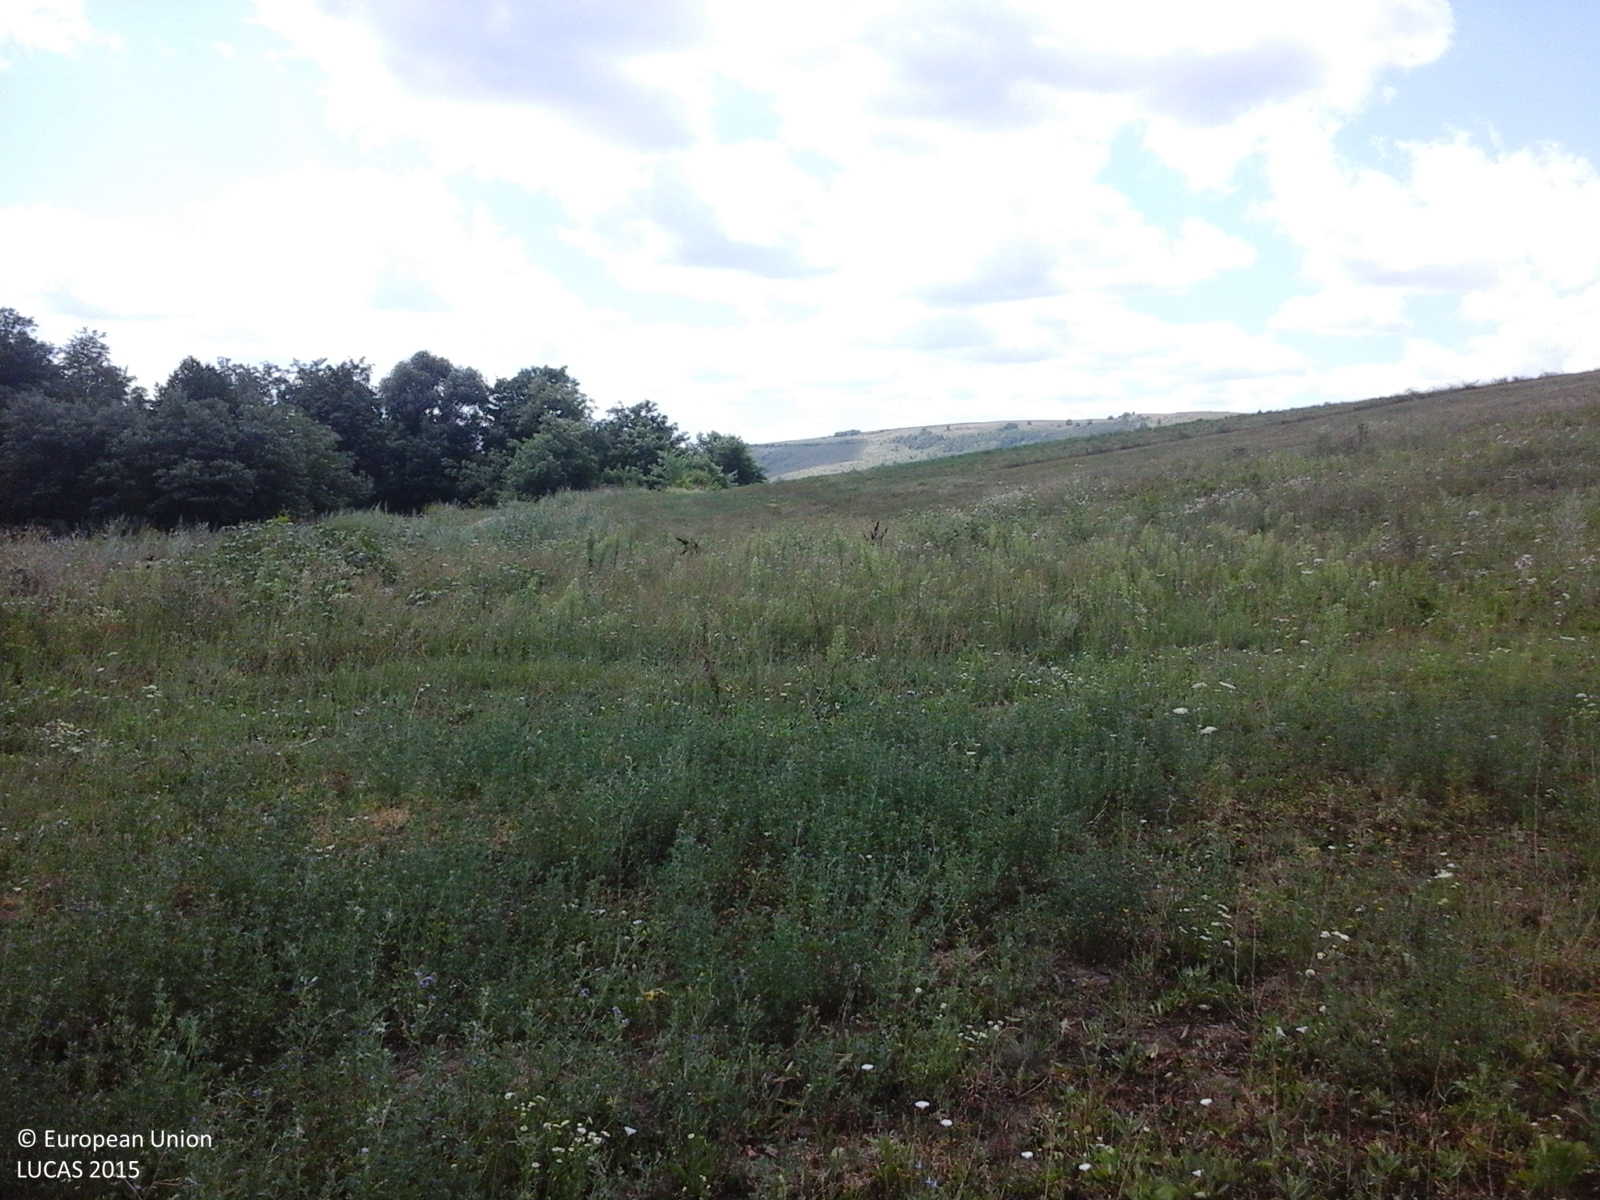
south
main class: Cropland
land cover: Lucerne
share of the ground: > 75 %
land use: Agriculture (excluding fallow land and kitchen gardens)
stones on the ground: < 10 %
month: July
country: RO
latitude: 46.5761
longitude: 27.2360
